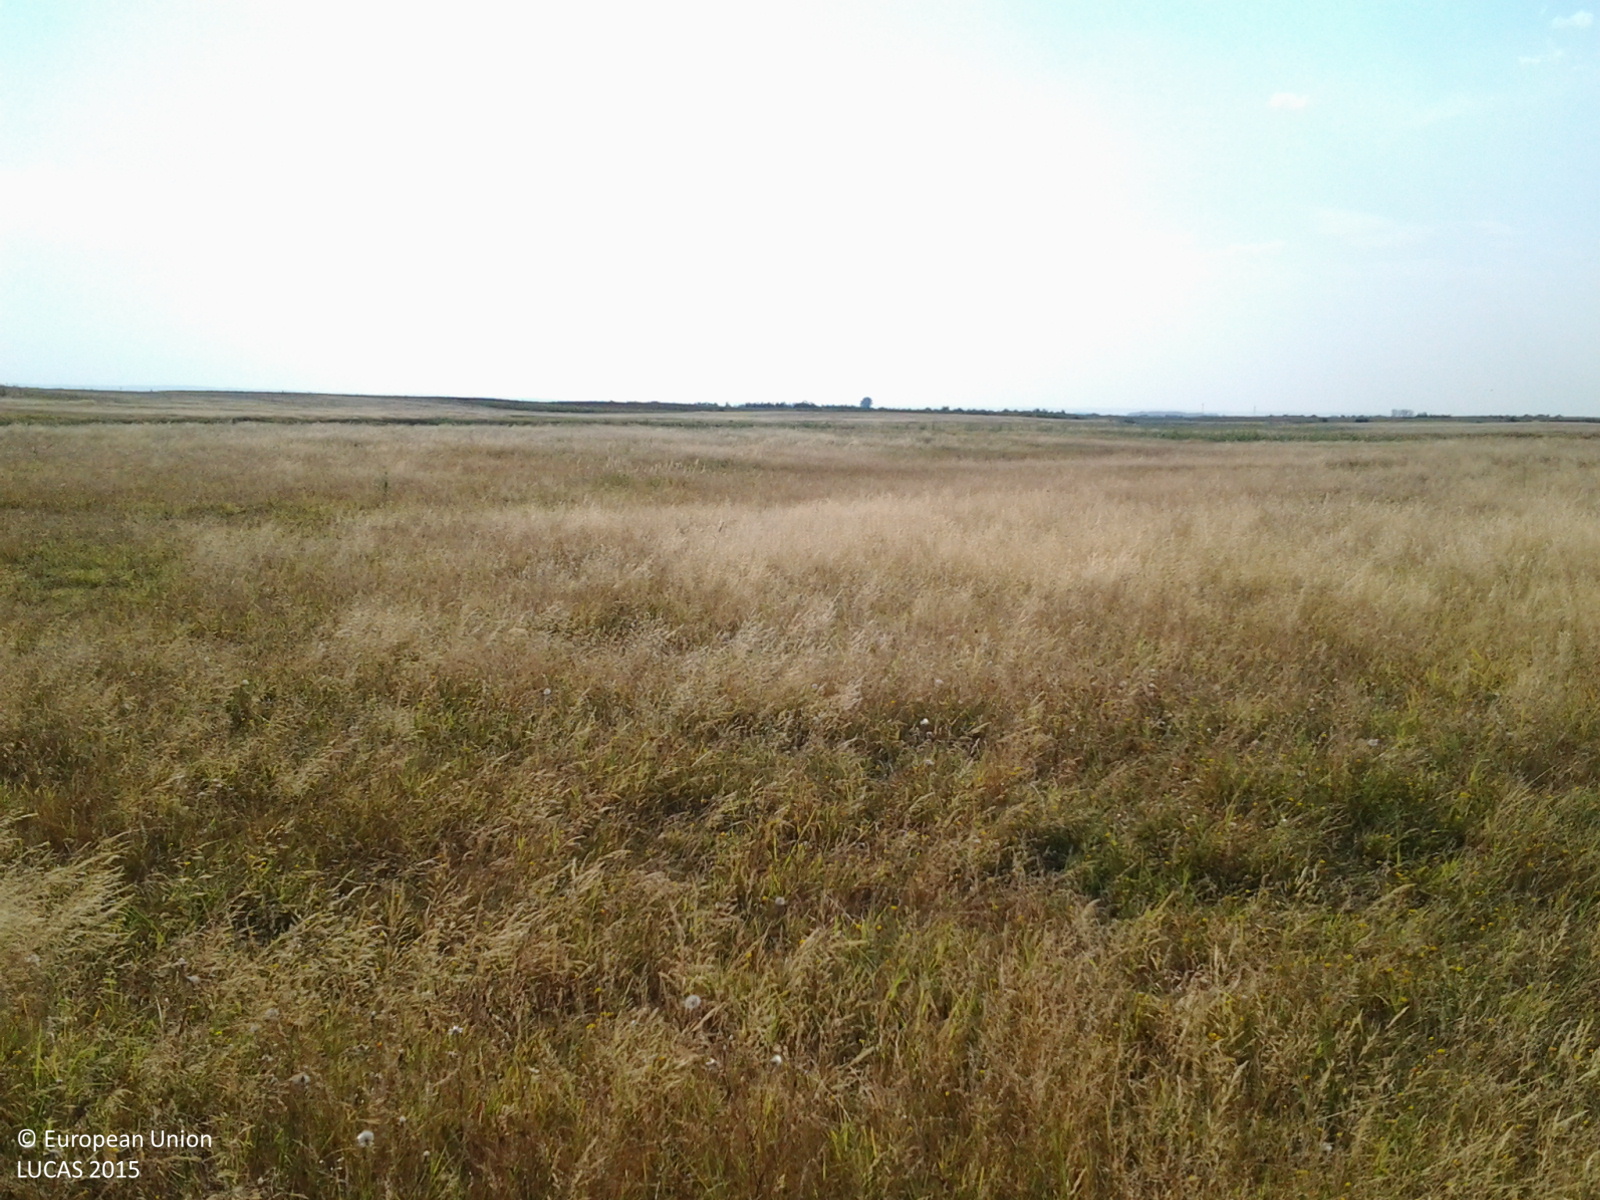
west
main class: Grassland
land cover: Spontaneously vegetated surfaces
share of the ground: > 75 %
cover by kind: herbaceous plants 100 %
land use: Fallow land
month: August
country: RO
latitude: 43.9117
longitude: 23.0037
